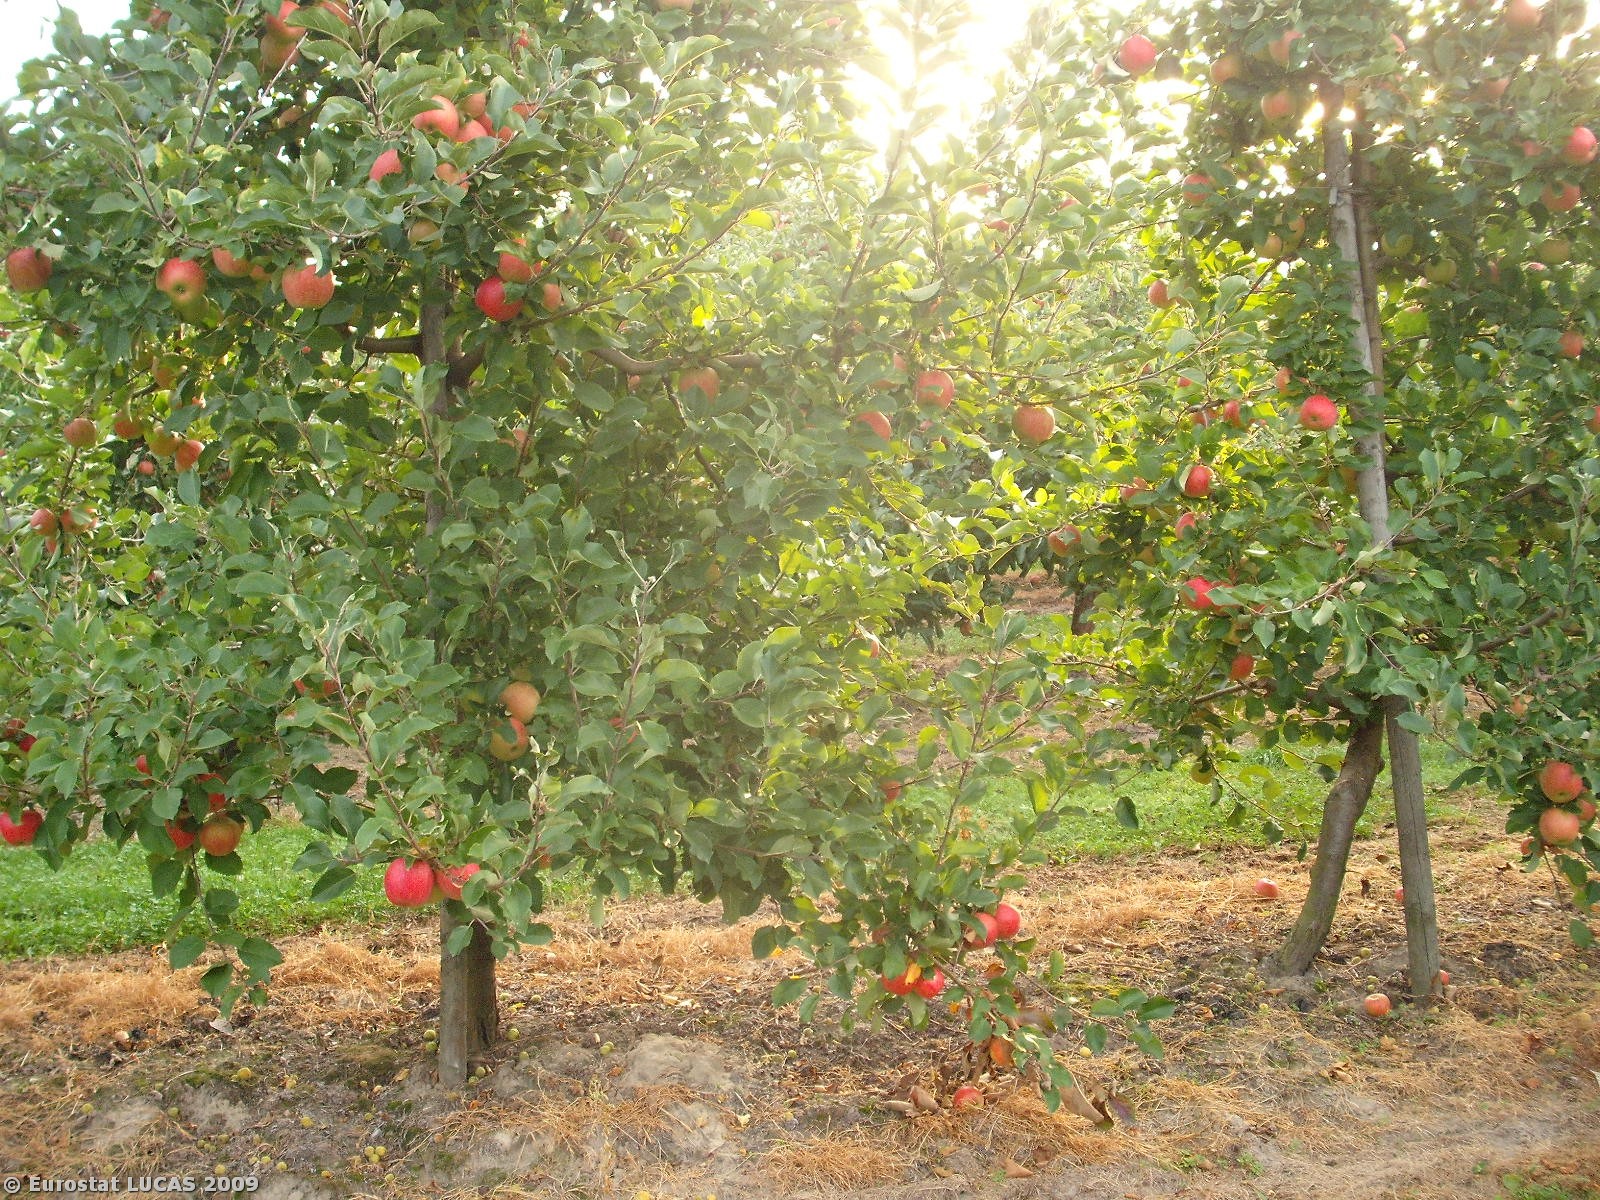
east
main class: Cropland
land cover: Apple fruit
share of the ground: 50 - 75 %
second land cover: Grassland with sparse tree/shrub cover
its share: > 75 %
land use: Agriculture (excluding fallow land and kitchen gardens)
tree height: < 5 m
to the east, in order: Apple fruit; Grassland with sparse tree/shrub cover; Cherry fruit; Grassland with sparse tree/shrub cover; Pear fruit; Grassland with sparse tree/shrub cover; Cherry fruit; Grassland with sparse tree/shrub cover; Electric lines; Grass margins; Paved roads, cycling and walking lanes; Fences; Apple fruit; Grassland with sparse tree/shrub cover; Fences; Apple fruit; Grassland with sparse tree/shrub cover
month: September
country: PL
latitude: 51.7688
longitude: 20.6623
